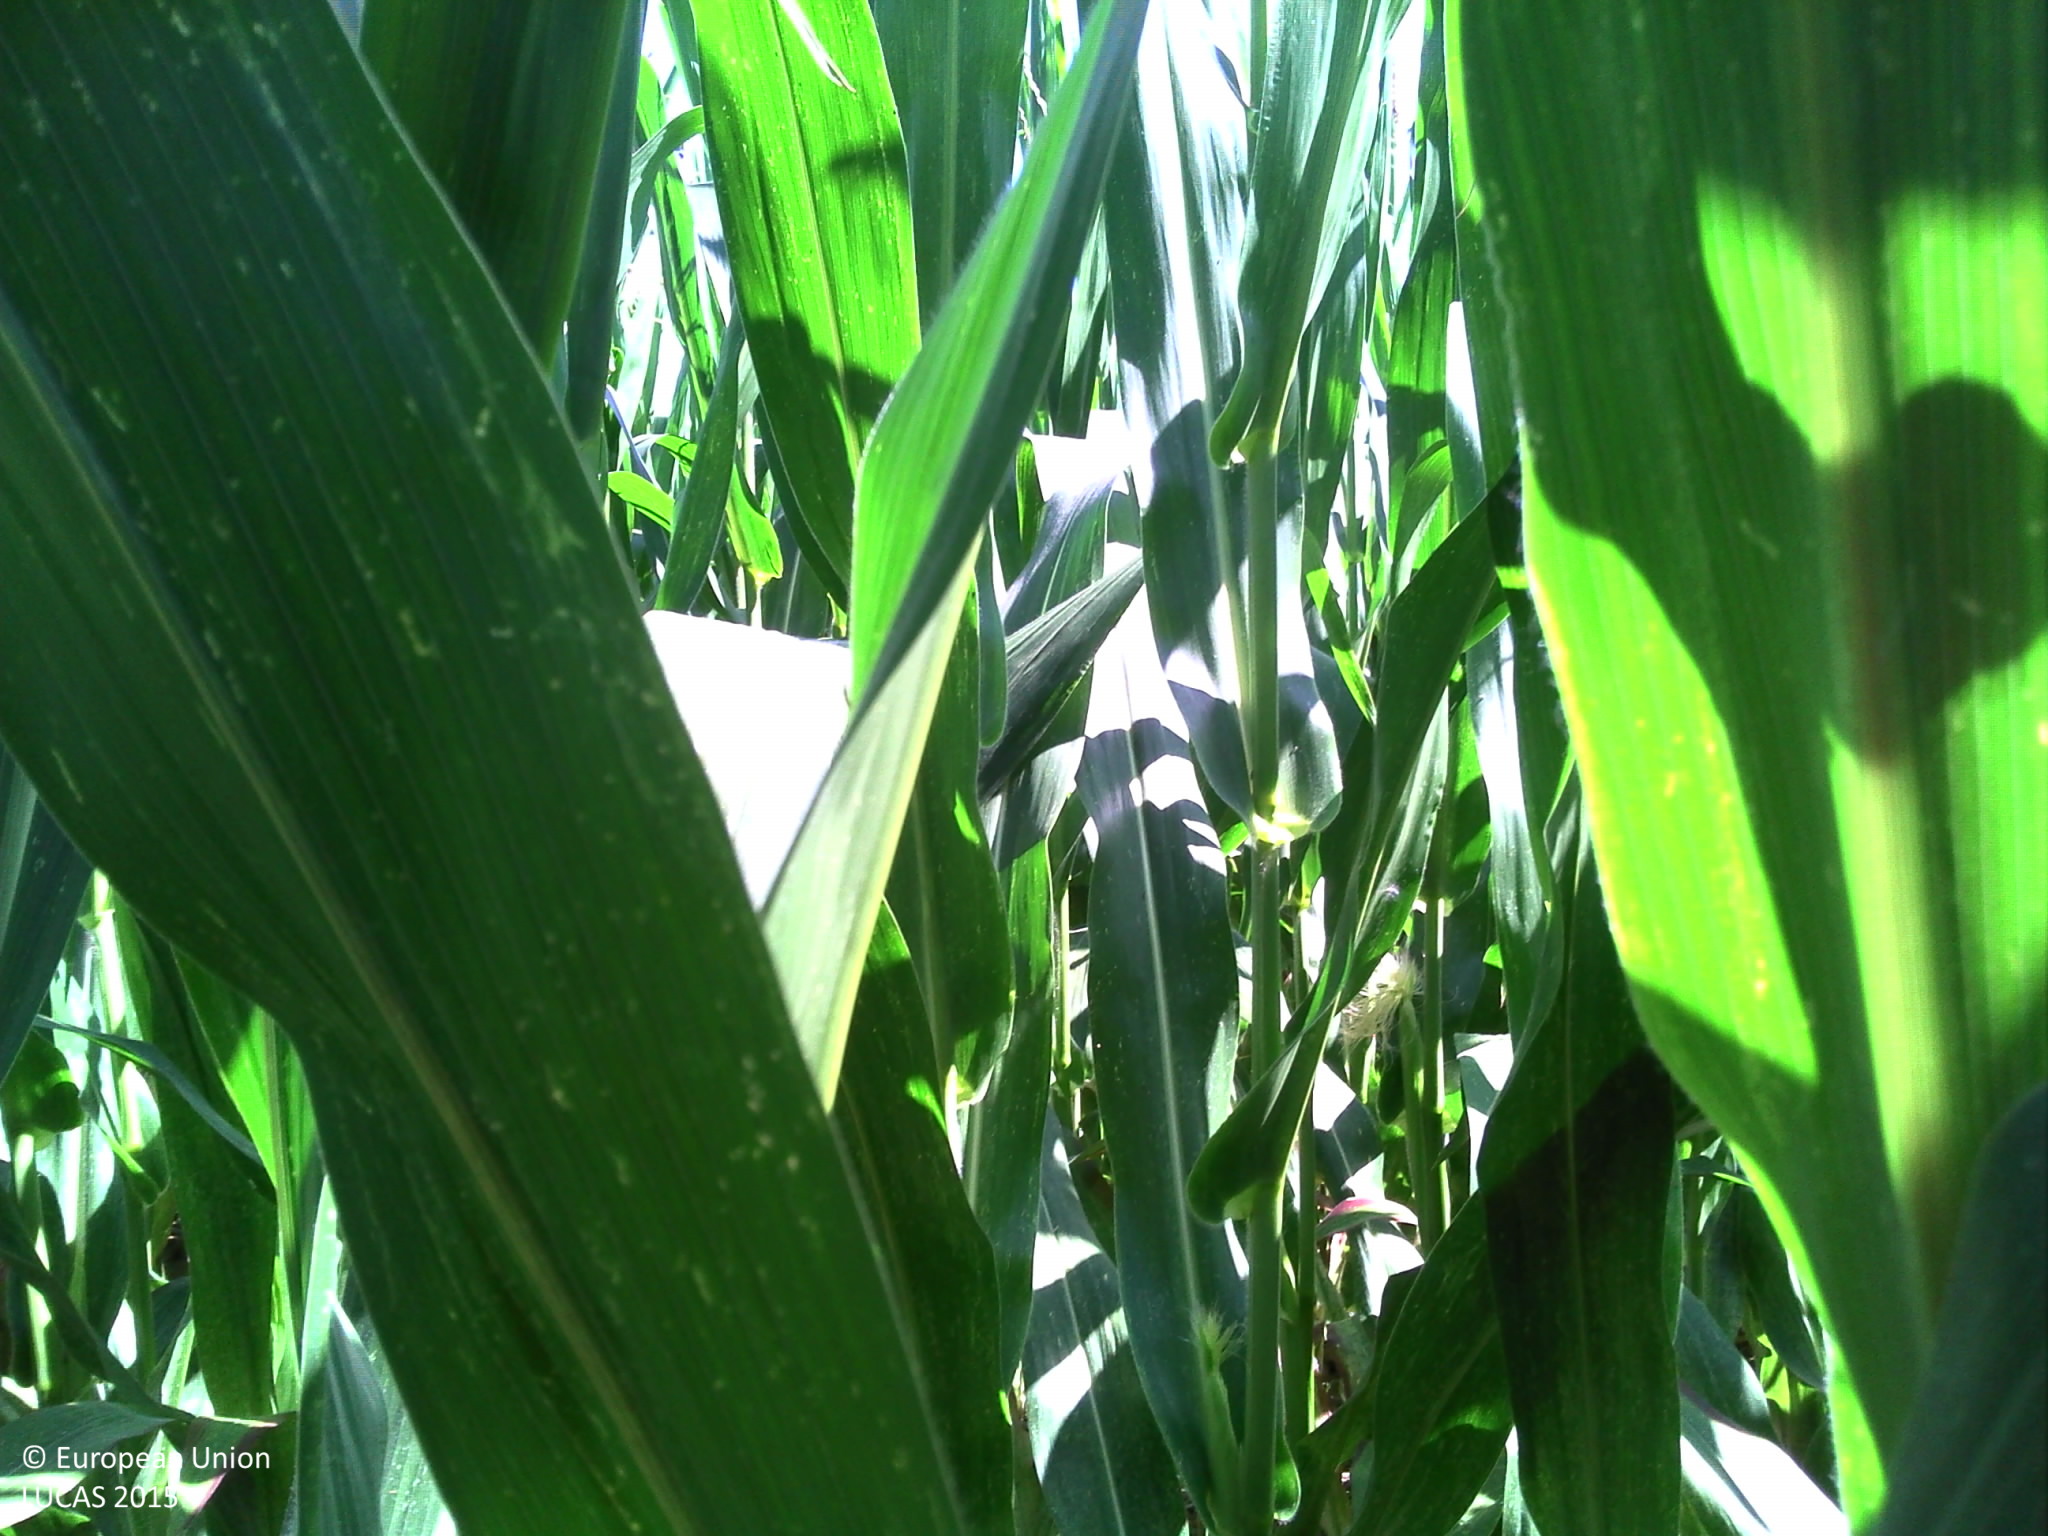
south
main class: Cropland
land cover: Maize
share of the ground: > 75 %
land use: Agriculture (excluding fallow land and kitchen gardens)
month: July
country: FR
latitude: 43.9515
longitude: 0.7134
